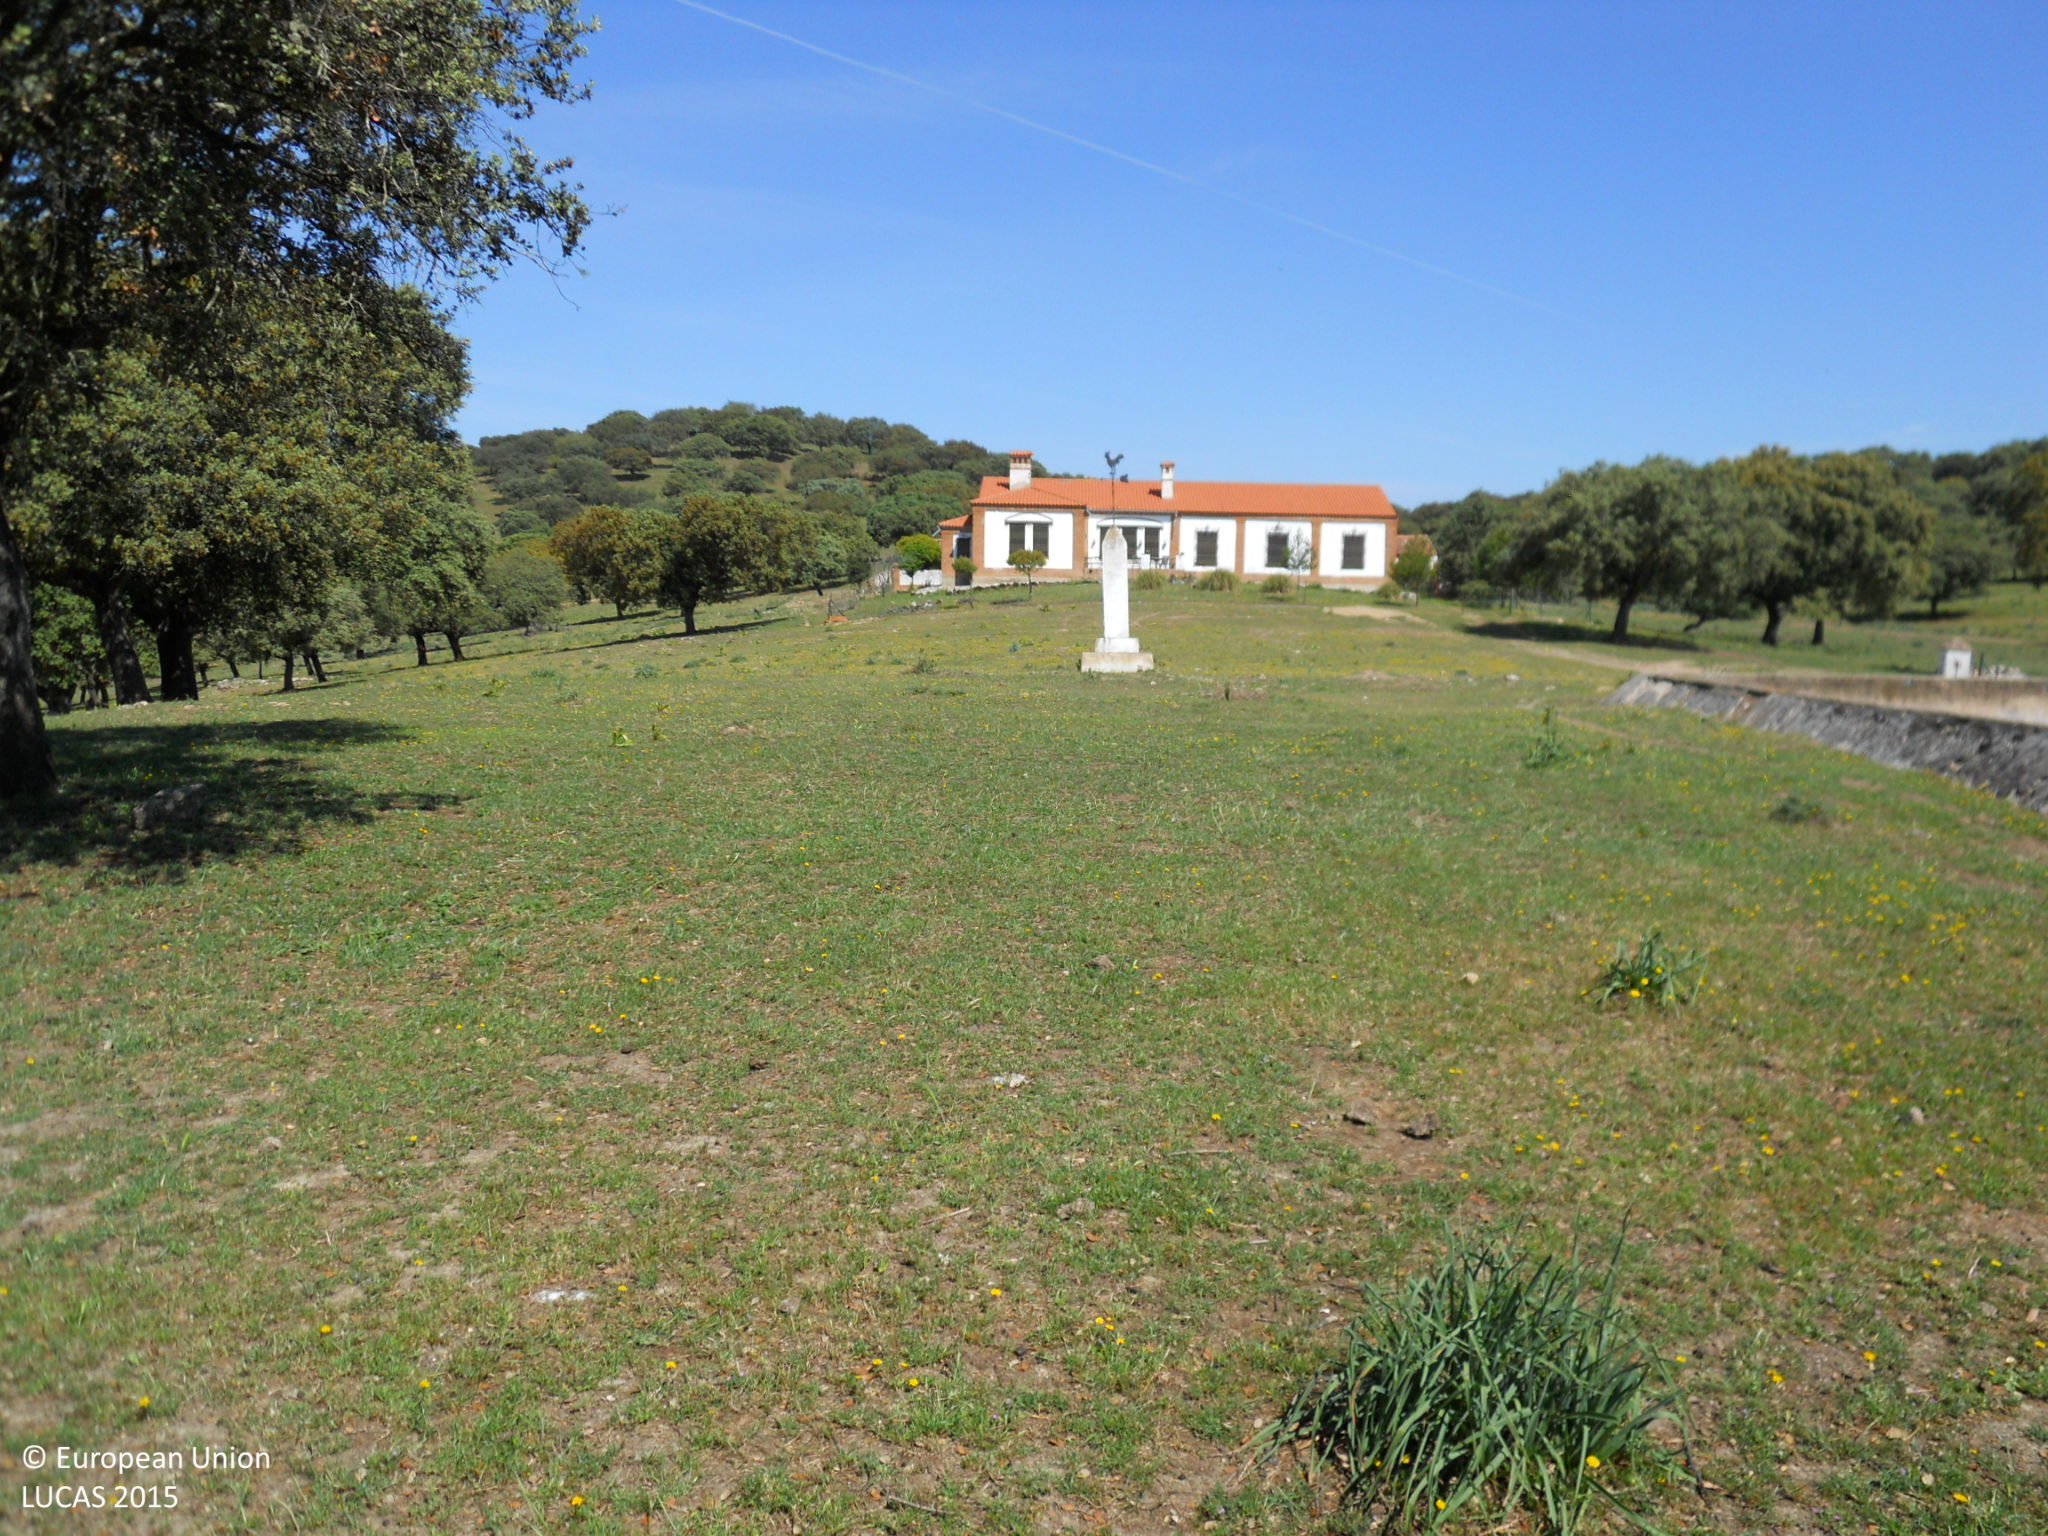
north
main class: Woodland
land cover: Broadleaved woodland
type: broadleaved evergreen forest
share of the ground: > 75 %
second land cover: Grassland without tree/shrub cover
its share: > 75 %
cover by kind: broadleaved forest trees 90 %, herbaceous plants 10 %
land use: Forestry
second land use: Agriculture (excluding fallow land and kitchen gardens)
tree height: > 5 m
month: April
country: ES
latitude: 39.2192
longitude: -6.7619
